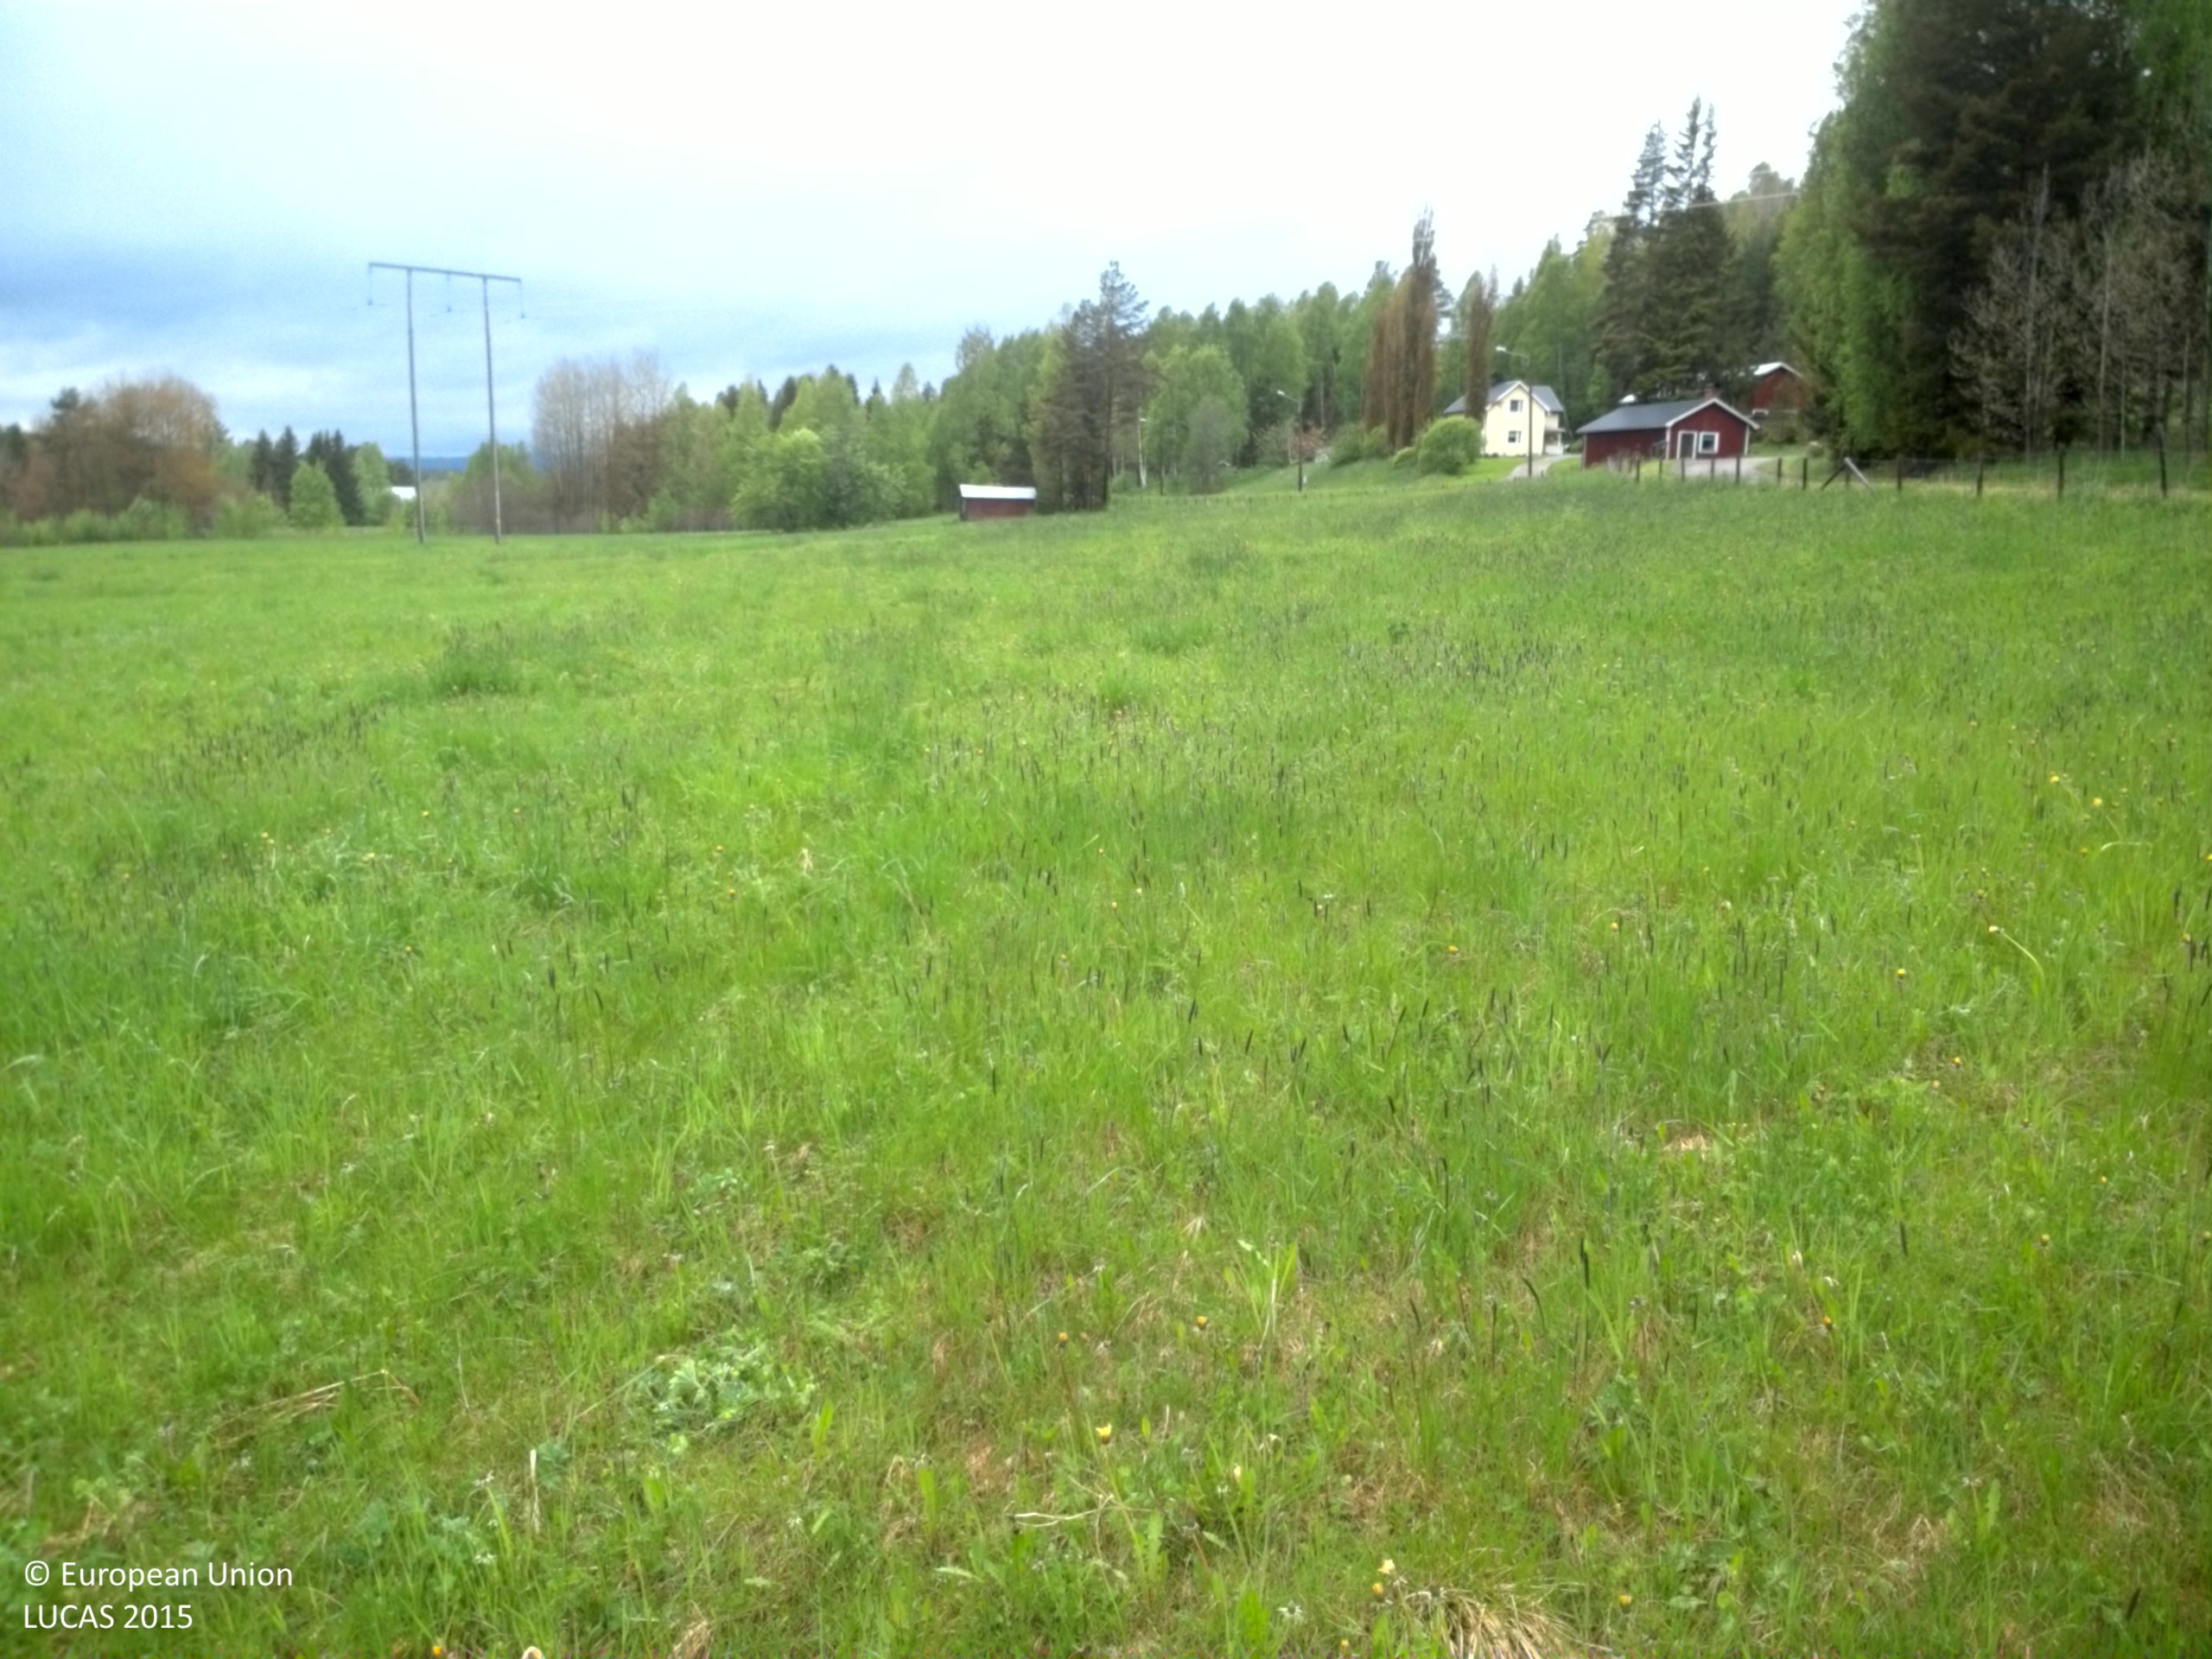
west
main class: Grassland
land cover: Spontaneously vegetated surfaces
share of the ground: > 75 %
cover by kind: herbaceous plants 100 %
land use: Agriculture (excluding fallow land and kitchen gardens)
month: June
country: SE
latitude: 63.1568
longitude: 16.9828
